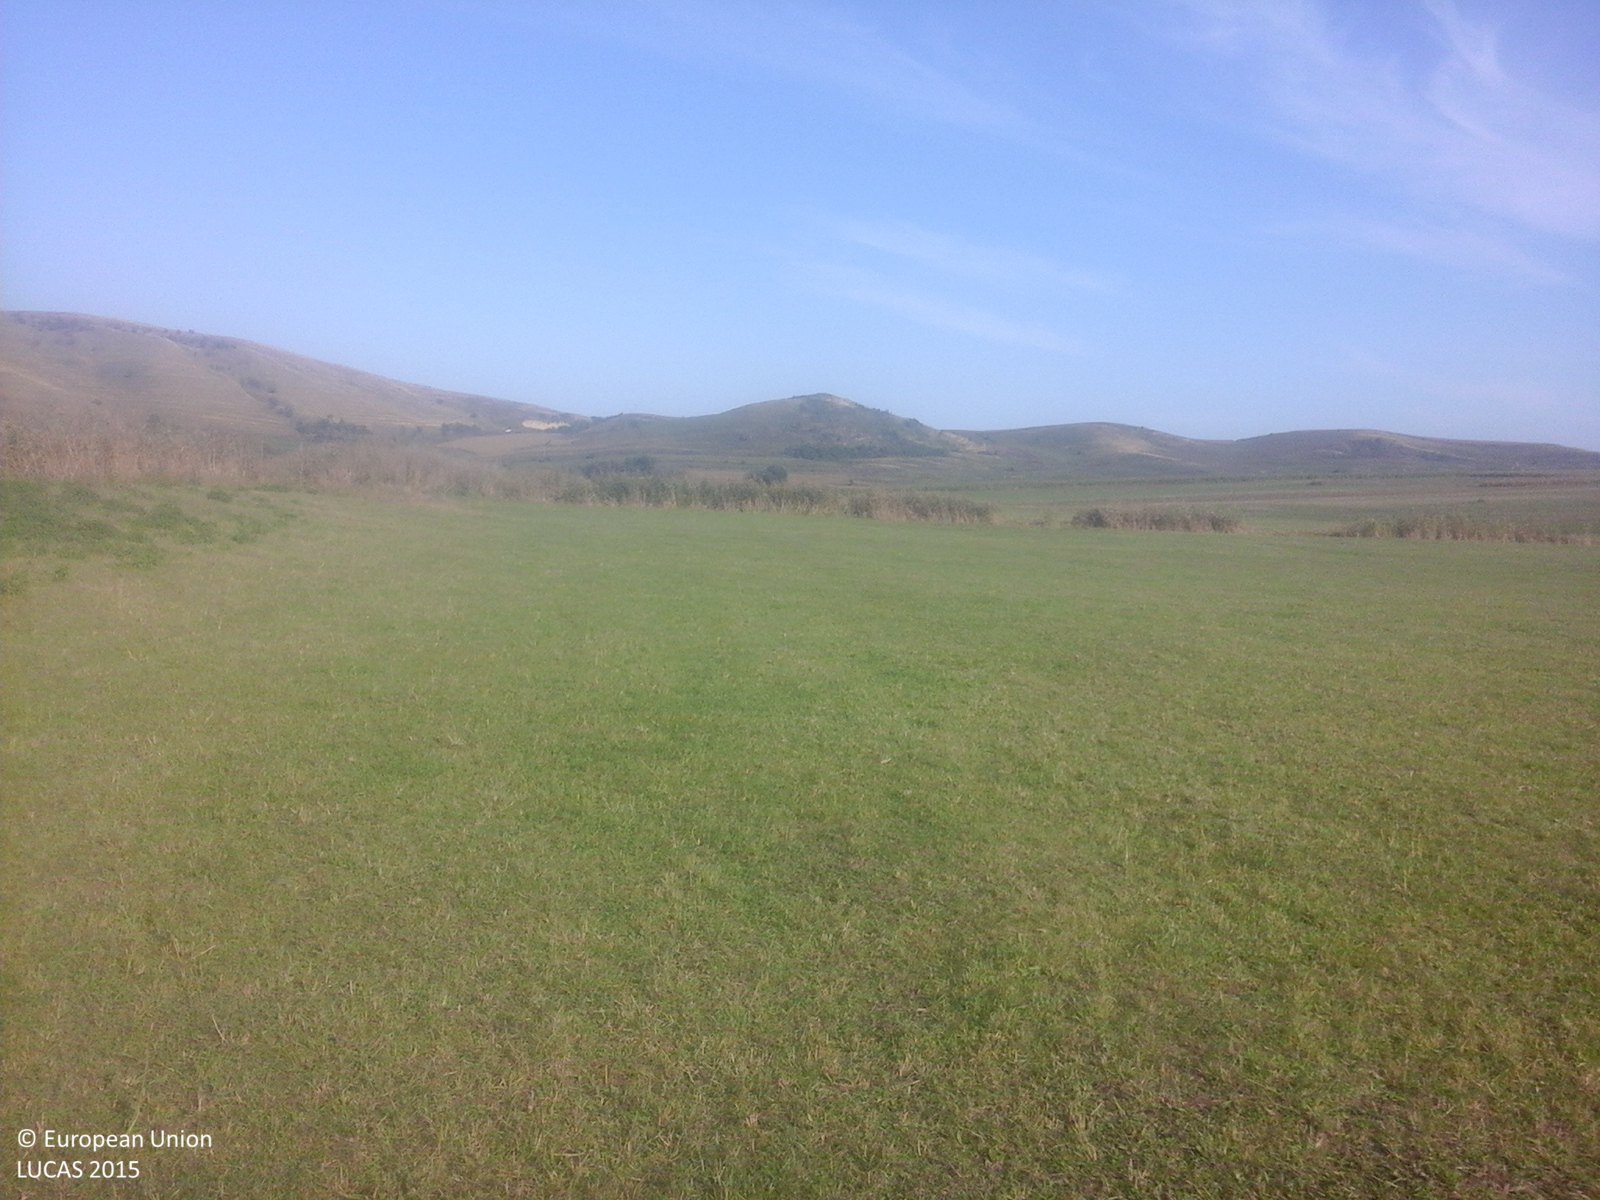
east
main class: Grassland
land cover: Grassland without tree/shrub cover
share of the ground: > 75 %
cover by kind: herbaceous plants 100 %
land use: Agriculture (excluding fallow land and kitchen gardens)
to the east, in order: Grassland without tree/shrub cover; Ditches and canals; Grassland without tree/shrub cover
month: October
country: RO
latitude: 45.9311
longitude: 24.0406
